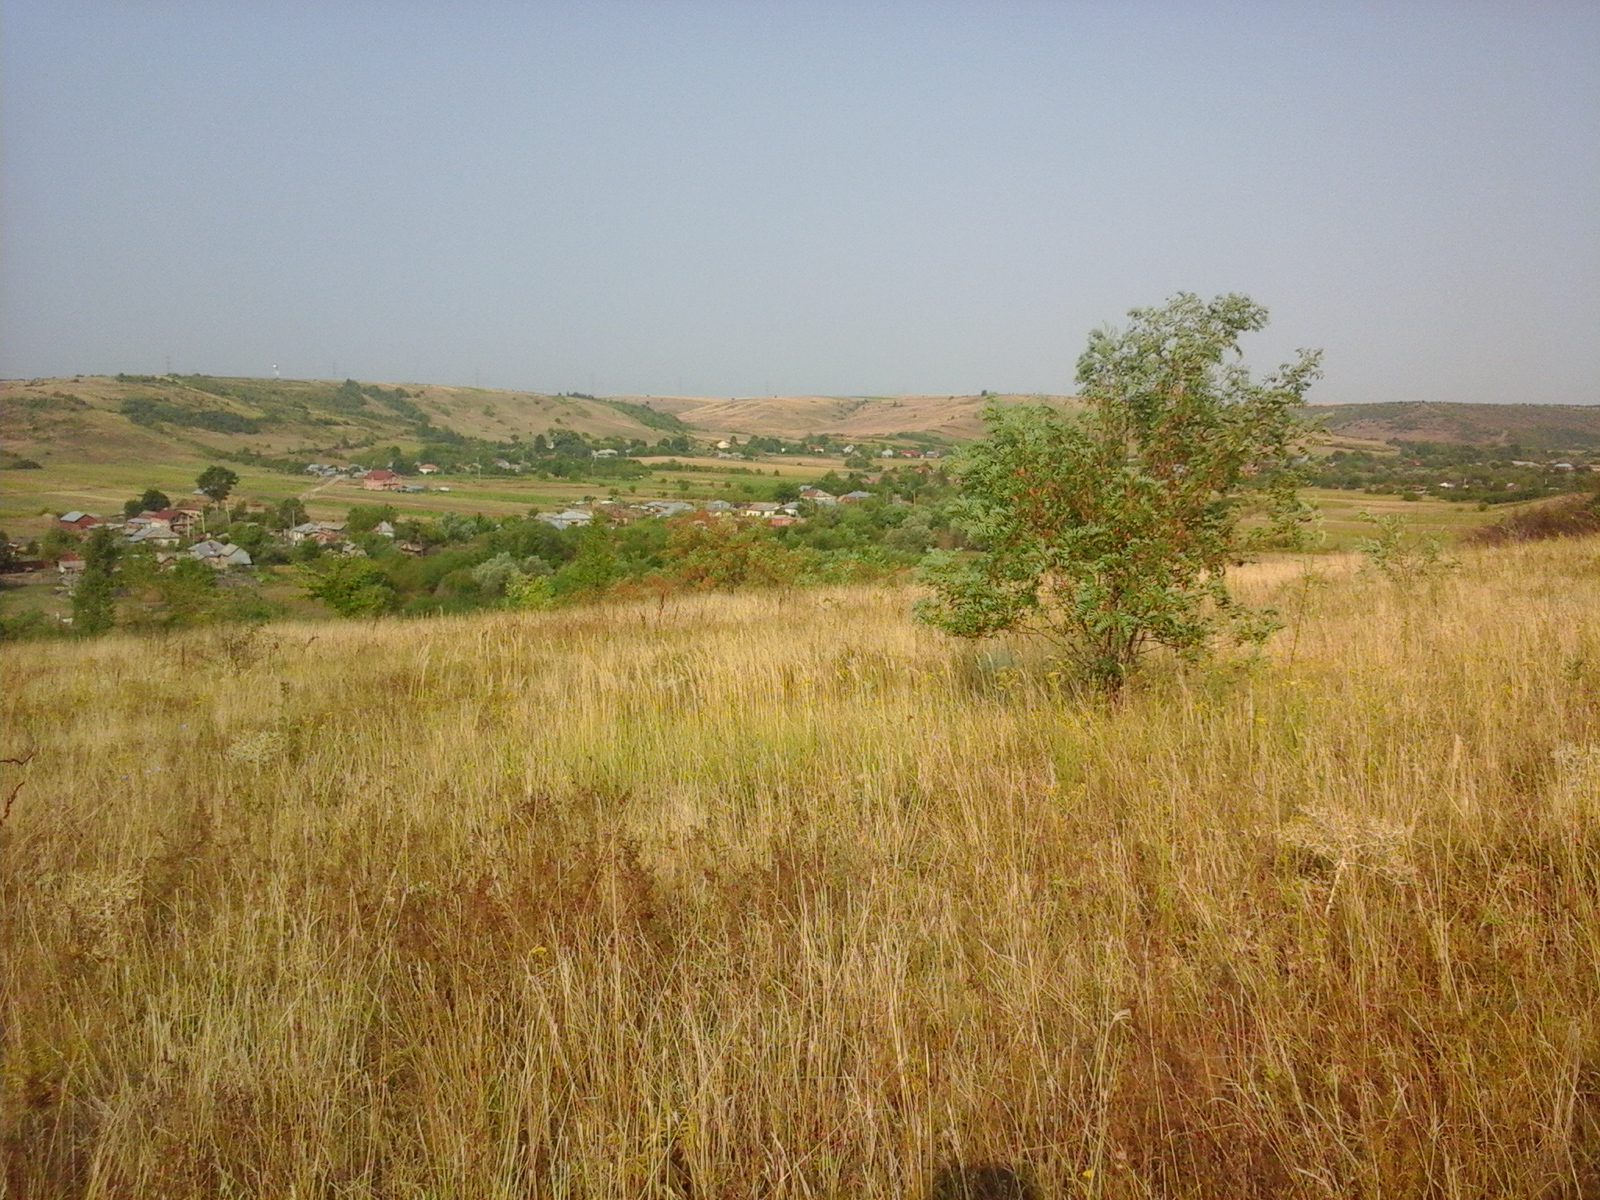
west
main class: Grassland
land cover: Grassland with sparse tree/shrub cover
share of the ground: > 75 %
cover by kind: herbaceous plants 90 %, broadleaved forest trees 5 %, shrubs 5 %
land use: Fallow land
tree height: < 5 m
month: August
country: RO
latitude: 44.5120
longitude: 23.8592
